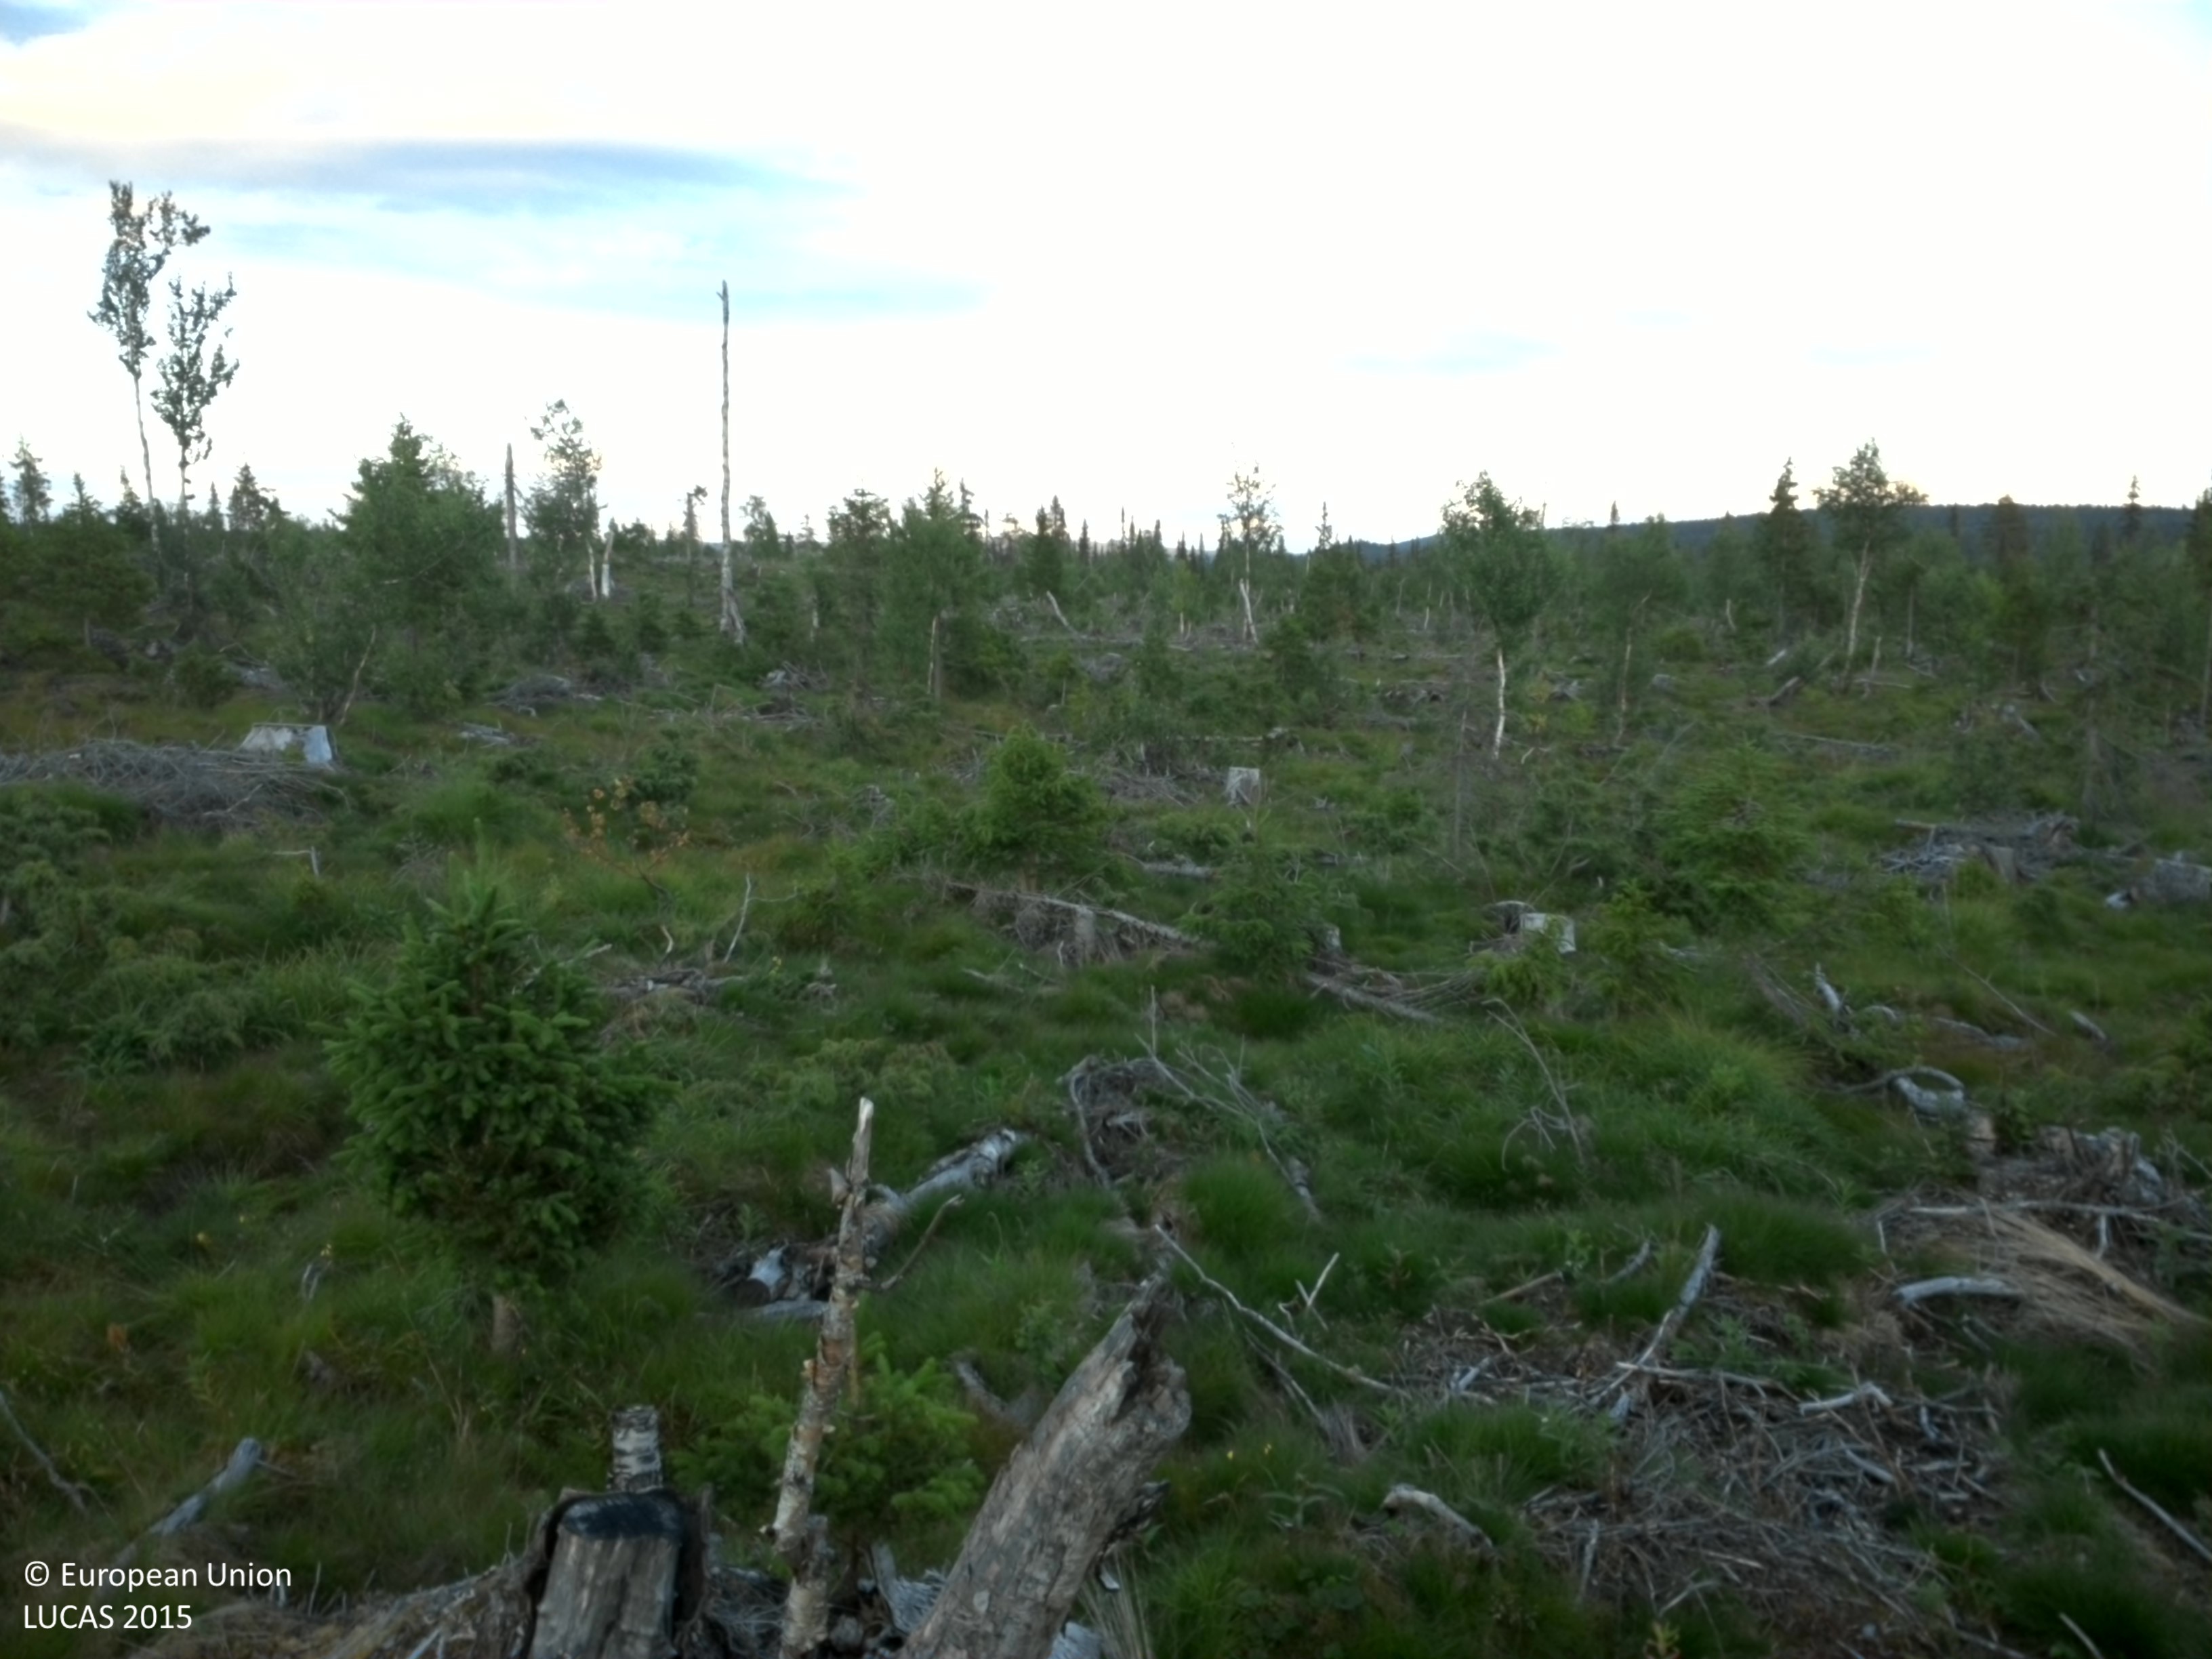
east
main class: Grassland
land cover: Grassland with sparse tree/shrub cover
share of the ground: > 75 %
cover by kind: herbaceous plants 90 %, coniferous forest trees 5 %, shrubs 5 %
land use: Forestry
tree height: < 5 m
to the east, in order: Grassland with sparse tree/shrub cover; Spruce dominated mixed woodland
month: August
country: SE
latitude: 65.0346
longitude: 15.8056
